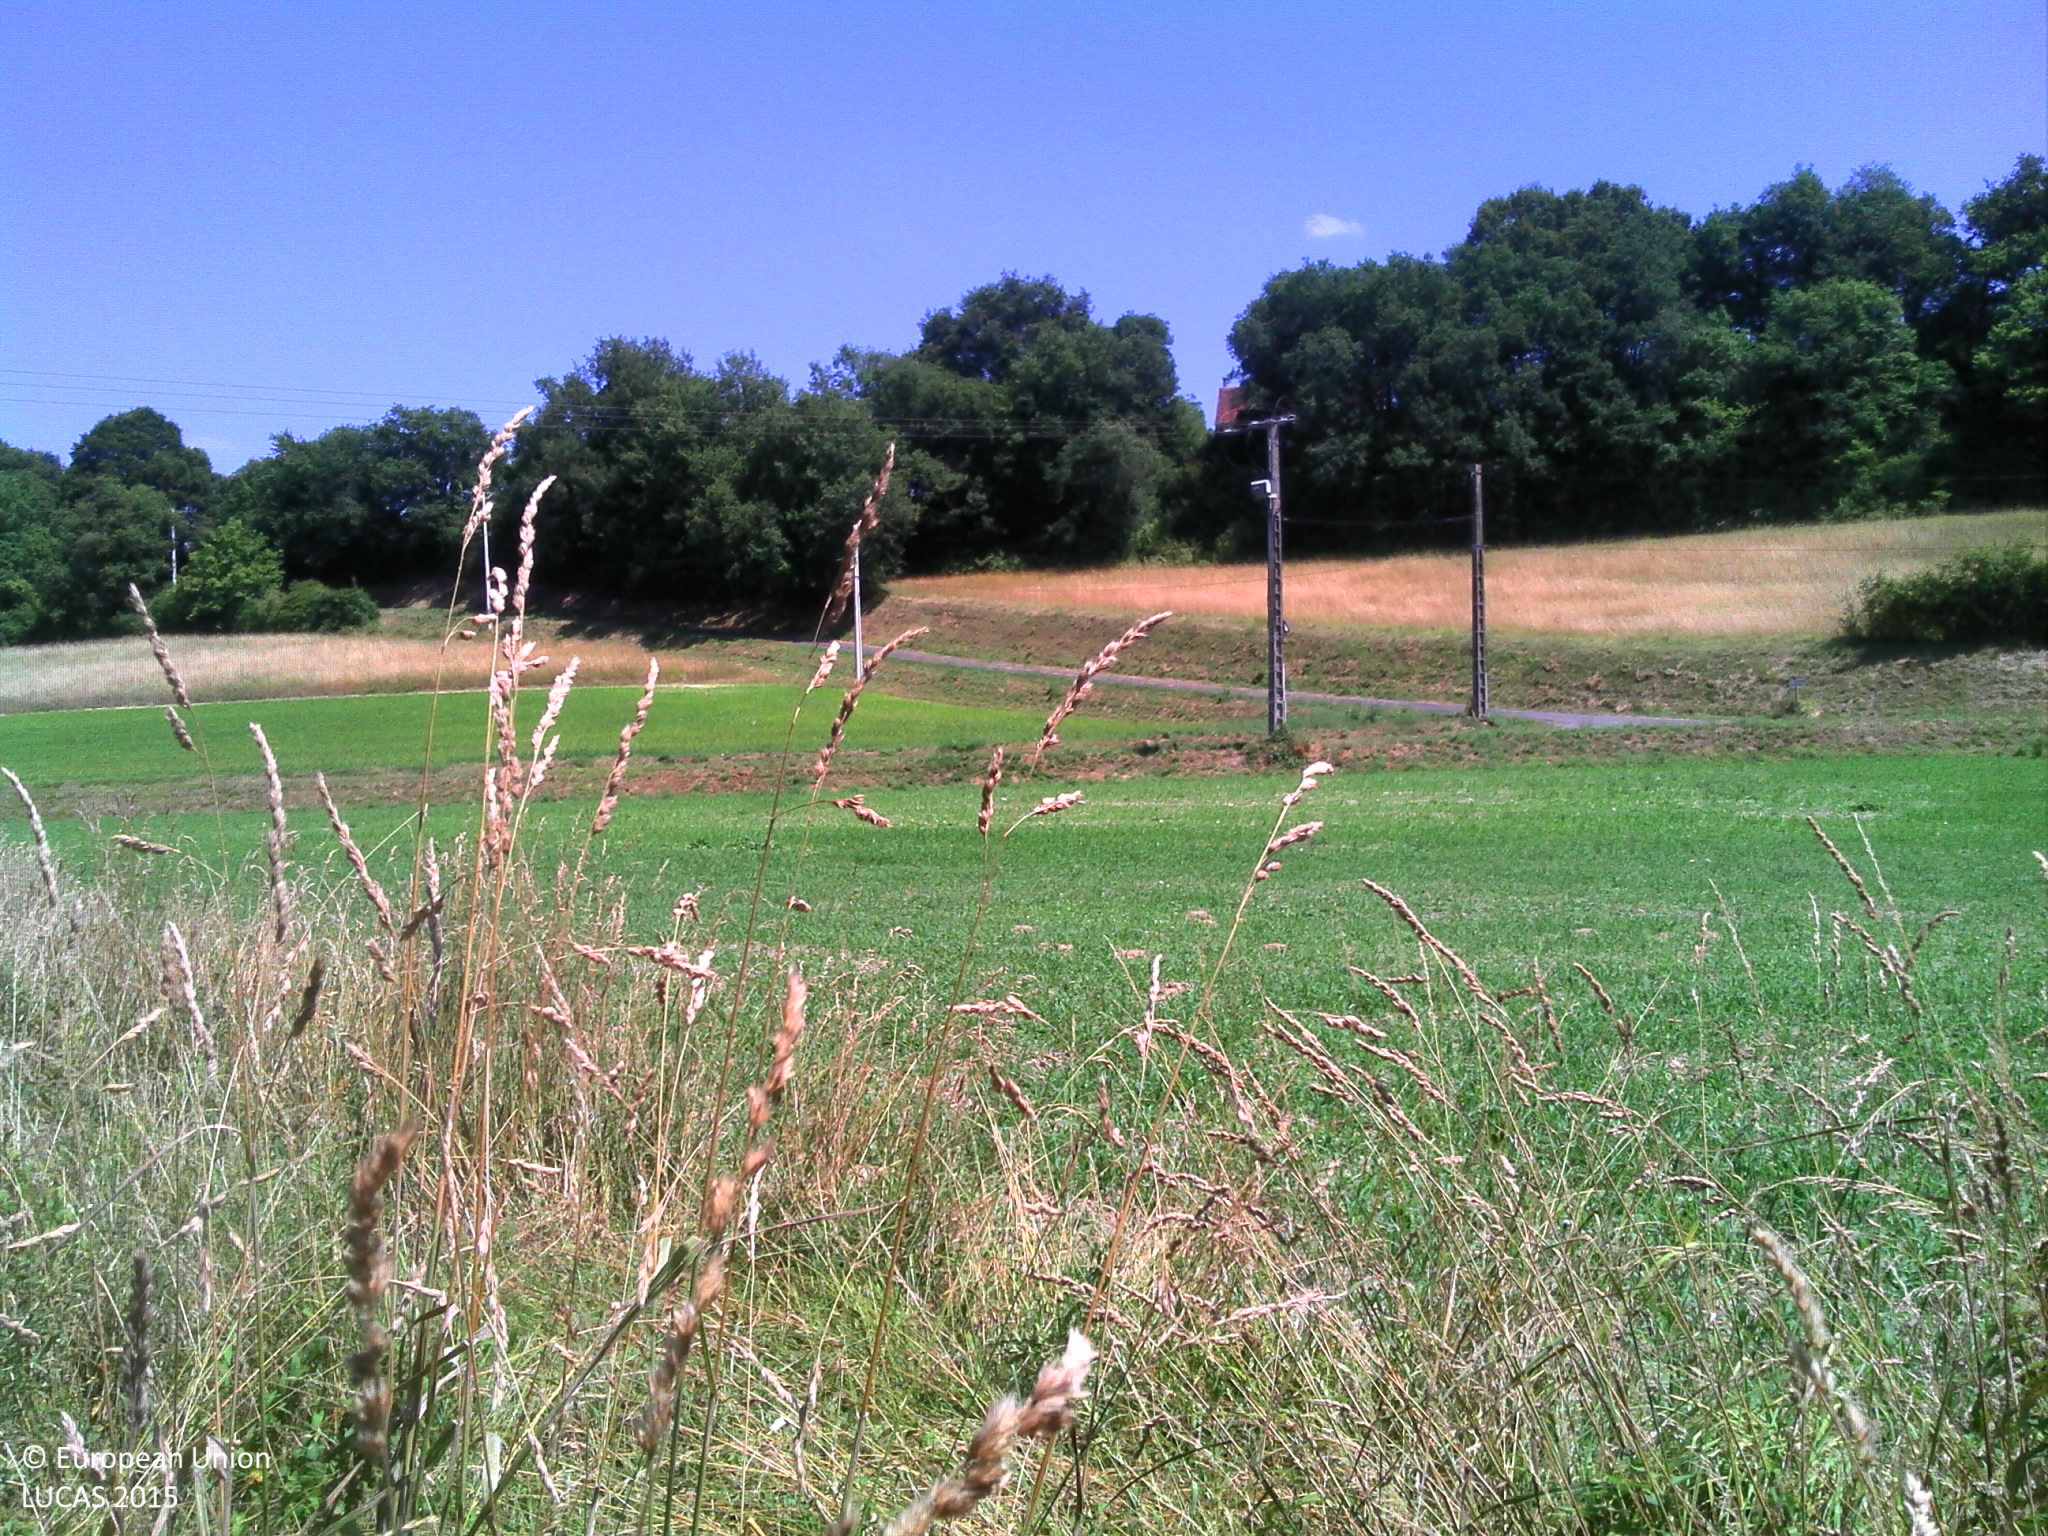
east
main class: Cropland
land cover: Maize
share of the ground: > 75 %
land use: Agriculture (excluding fallow land and kitchen gardens)
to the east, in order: Maize; Tracks; Abandoned hedges; Rivers and streams; Lines of trees; Abandoned hedges; Grass margins; Grassland without tree/shrub cover; Electric lines; Paved roads, cycling and walking lanes; Grassland without tree/shrub cover; Paved roads, cycling and walking lanes; Grassland without tree/shrub cover; Electric lines; Grass margins; Paved roads, cycling and walking lanes; Grass margins; Broadleaved woodland; Grassland without tree/shrub cover
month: July
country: FR
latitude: 46.9215
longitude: 0.8834
